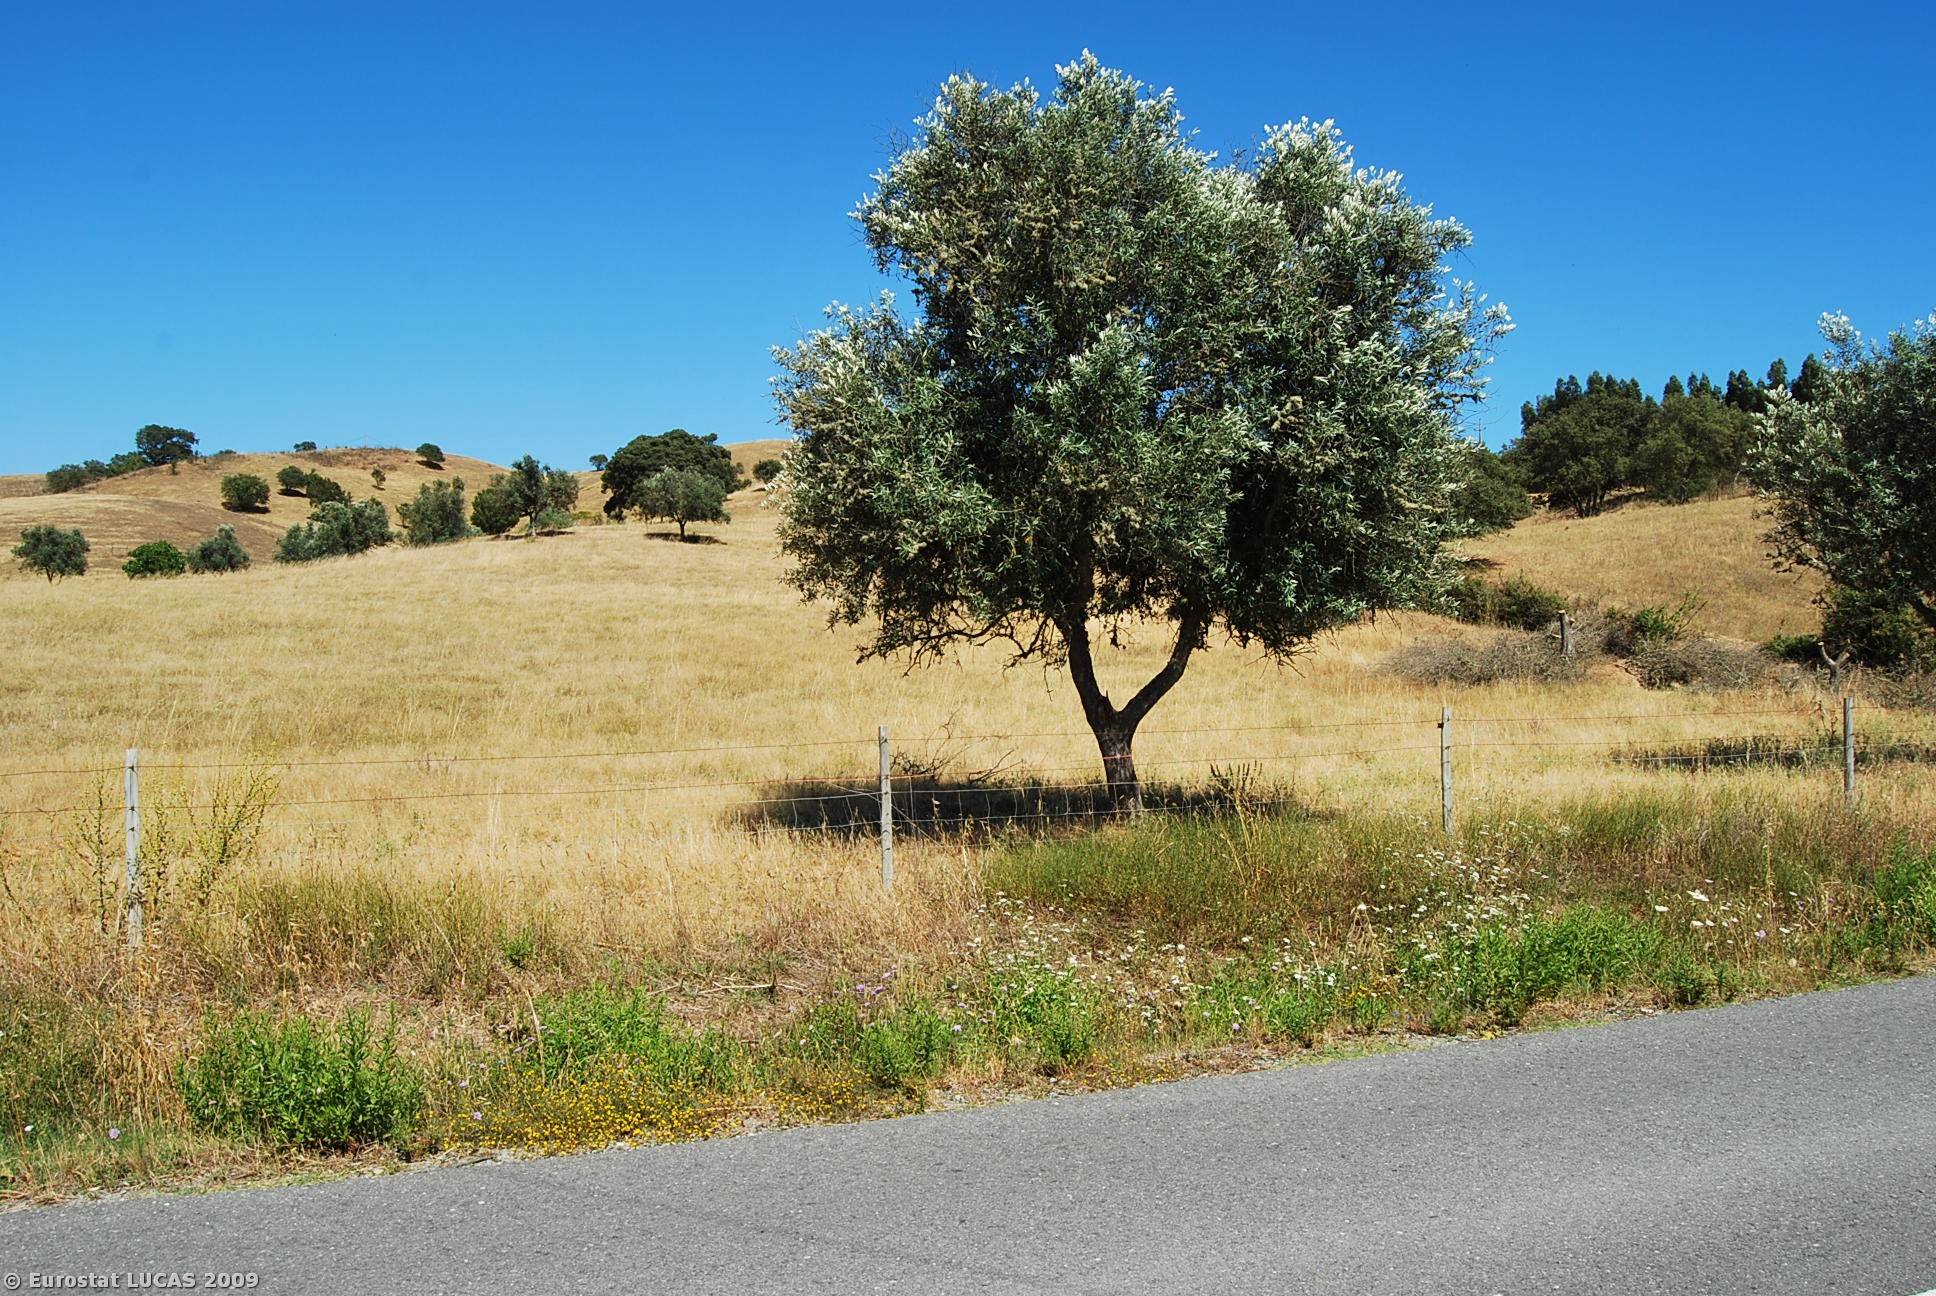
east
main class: Grassland
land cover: Spontaneously vegetated surfaces
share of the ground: > 75 %
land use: Fallow land
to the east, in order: Spontaneously vegetated surfaces; Other structural elements; Fences; Grass margins; Paved roads, cycling and walking lanes; Ditches and canals; Fences; Lines of trees; Grassland without tree/shrub cover; Lines of trees; Grassland without tree/shrub cover; Other structural elements; Grassland with sparse tree/shrub cover
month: July
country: PT
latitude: 37.6745
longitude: -8.4129
